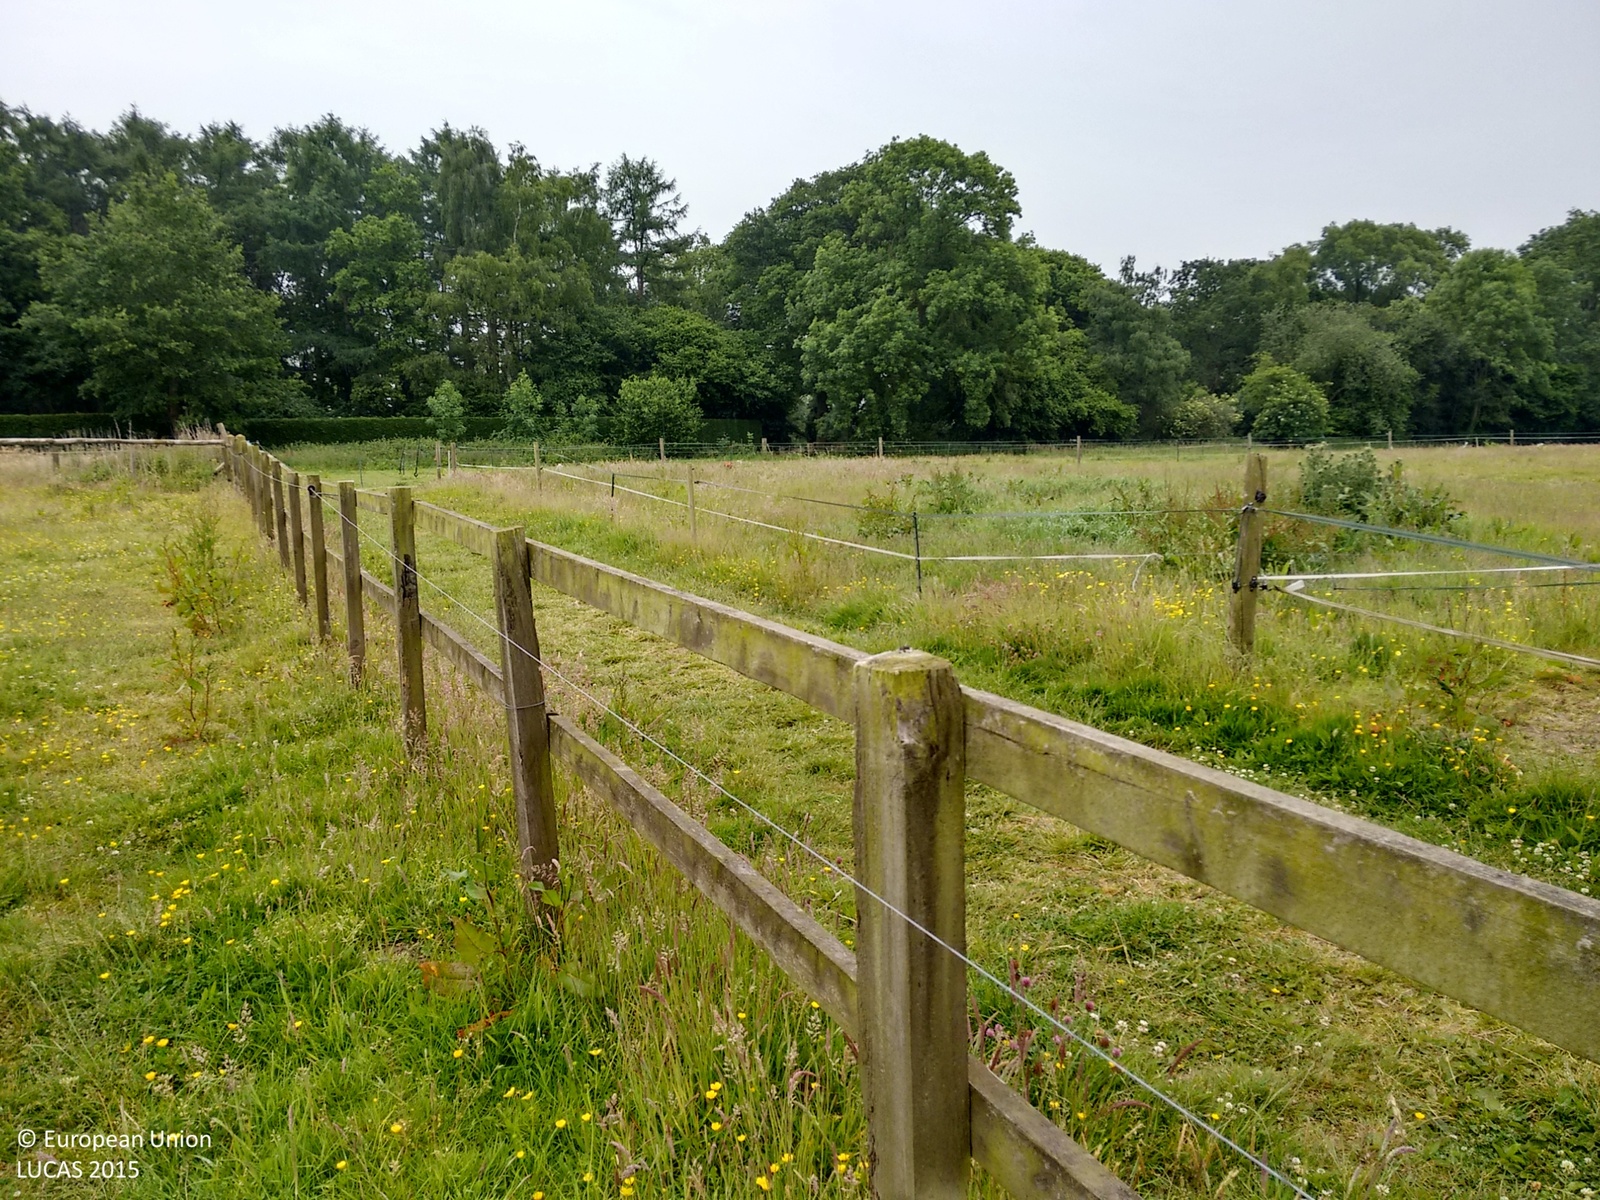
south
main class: Grassland
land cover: Grassland without tree/shrub cover
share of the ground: > 75 %
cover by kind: herbaceous plants 100 %
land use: Agriculture (excluding fallow land and kitchen gardens)
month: June
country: GB
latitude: 51.4136
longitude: -1.1610
